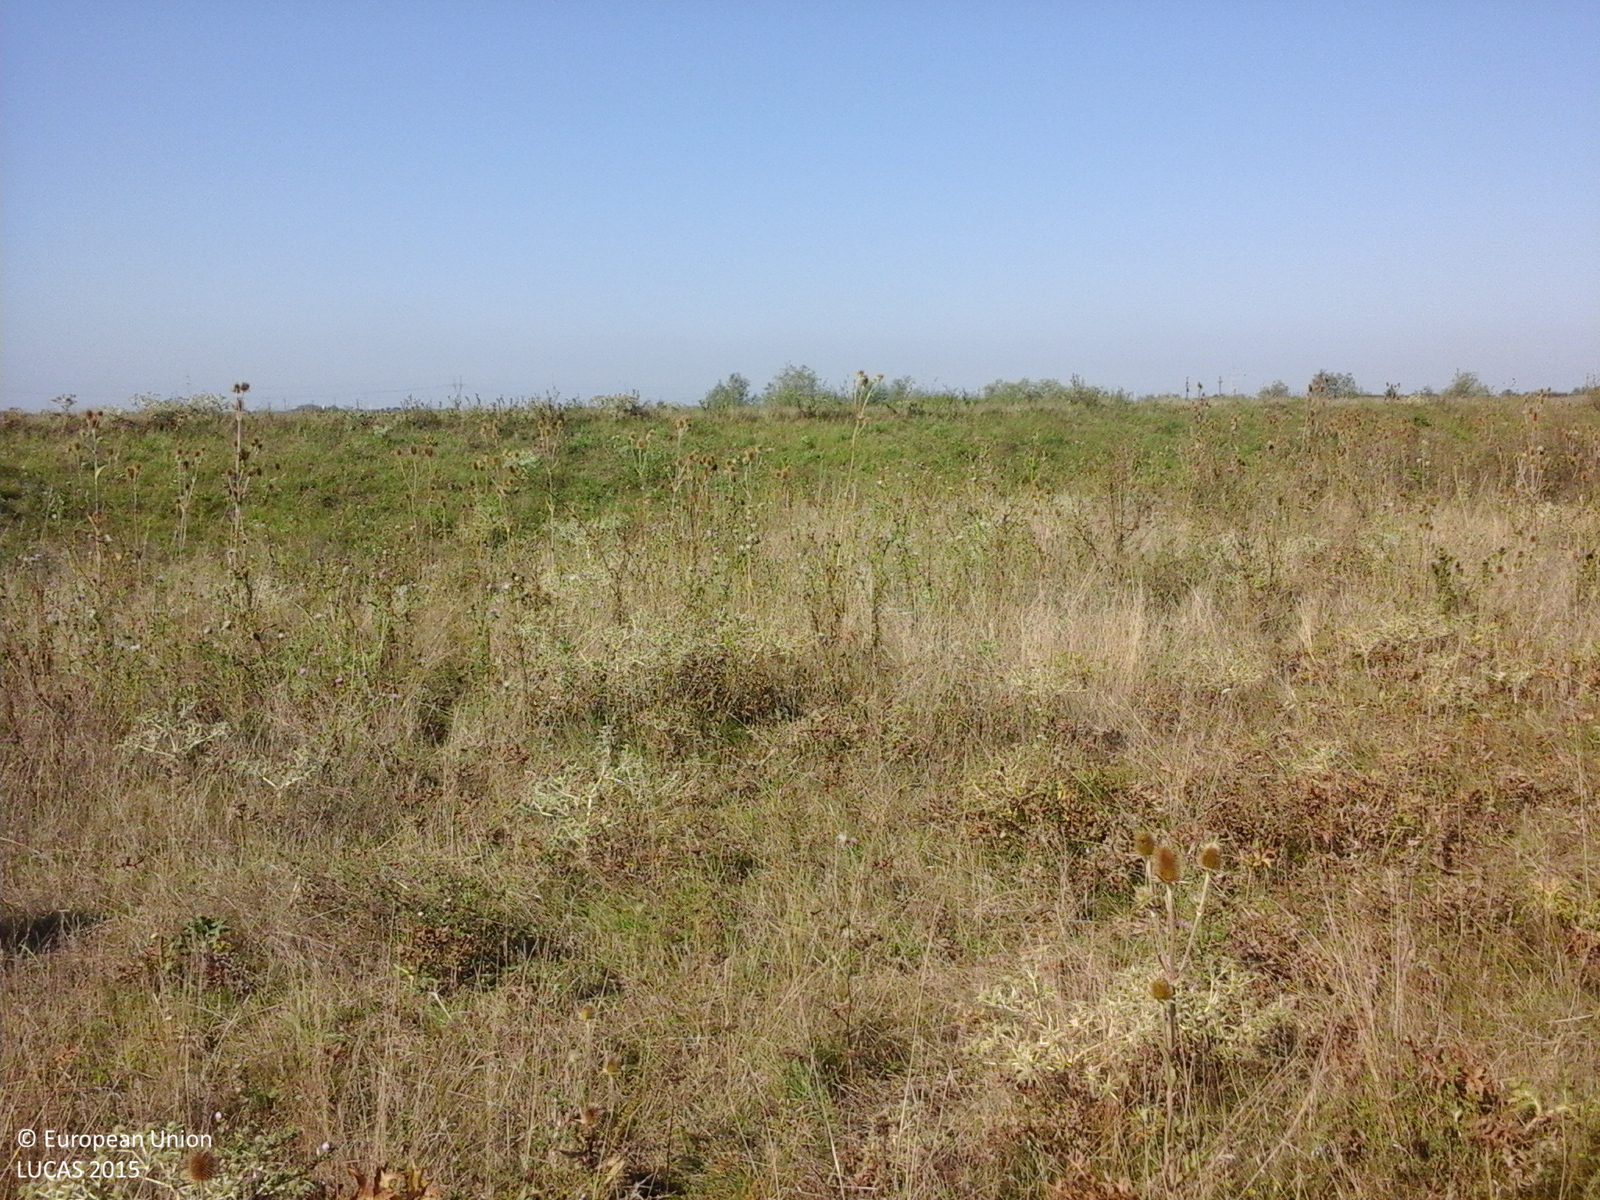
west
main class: Shrubland
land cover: Shrubland without tree cover
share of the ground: > 75 %
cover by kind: shrubs 95 %, herbaceous plants 5 %
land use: Semi-natural and natural areas not in use
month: August
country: RO
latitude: 45.6705
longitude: 21.3663
